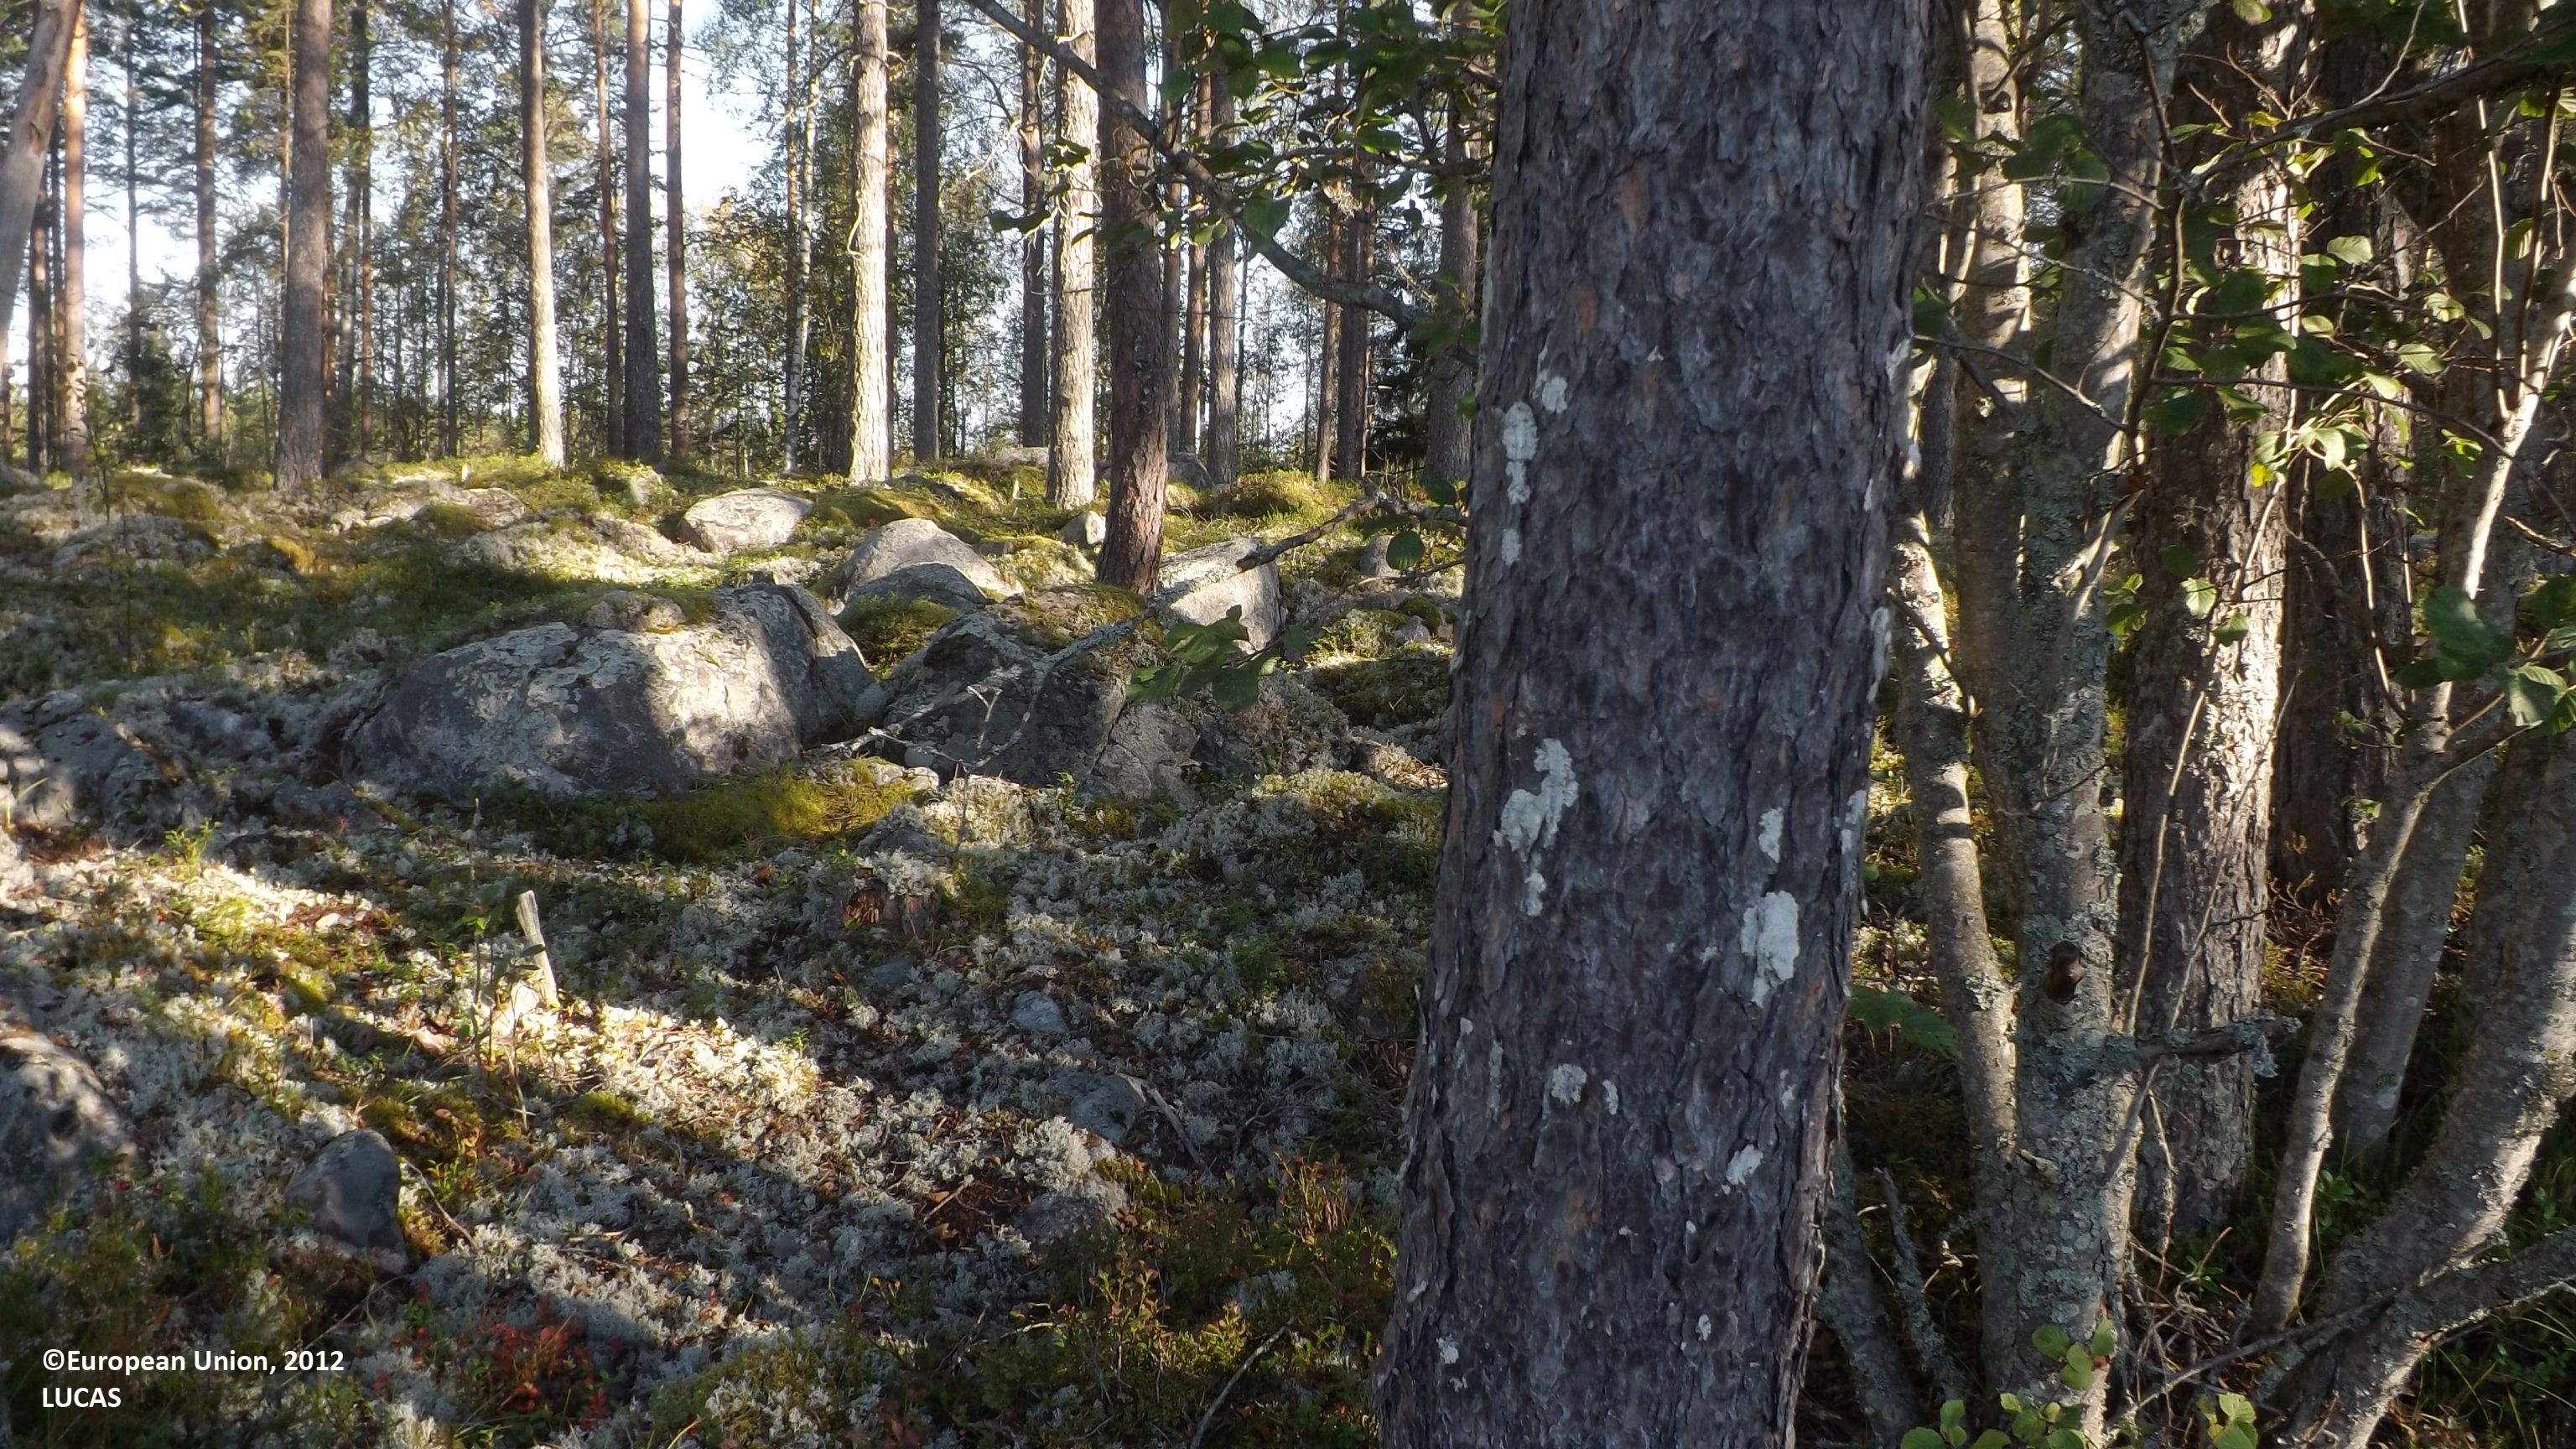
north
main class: Woodland
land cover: Pine dominated coniferous woodland
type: boreal forest
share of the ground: 25 - 50 %
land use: Forestry
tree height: > 5 m
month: August
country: FI
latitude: 63.7486
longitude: 24.0718
